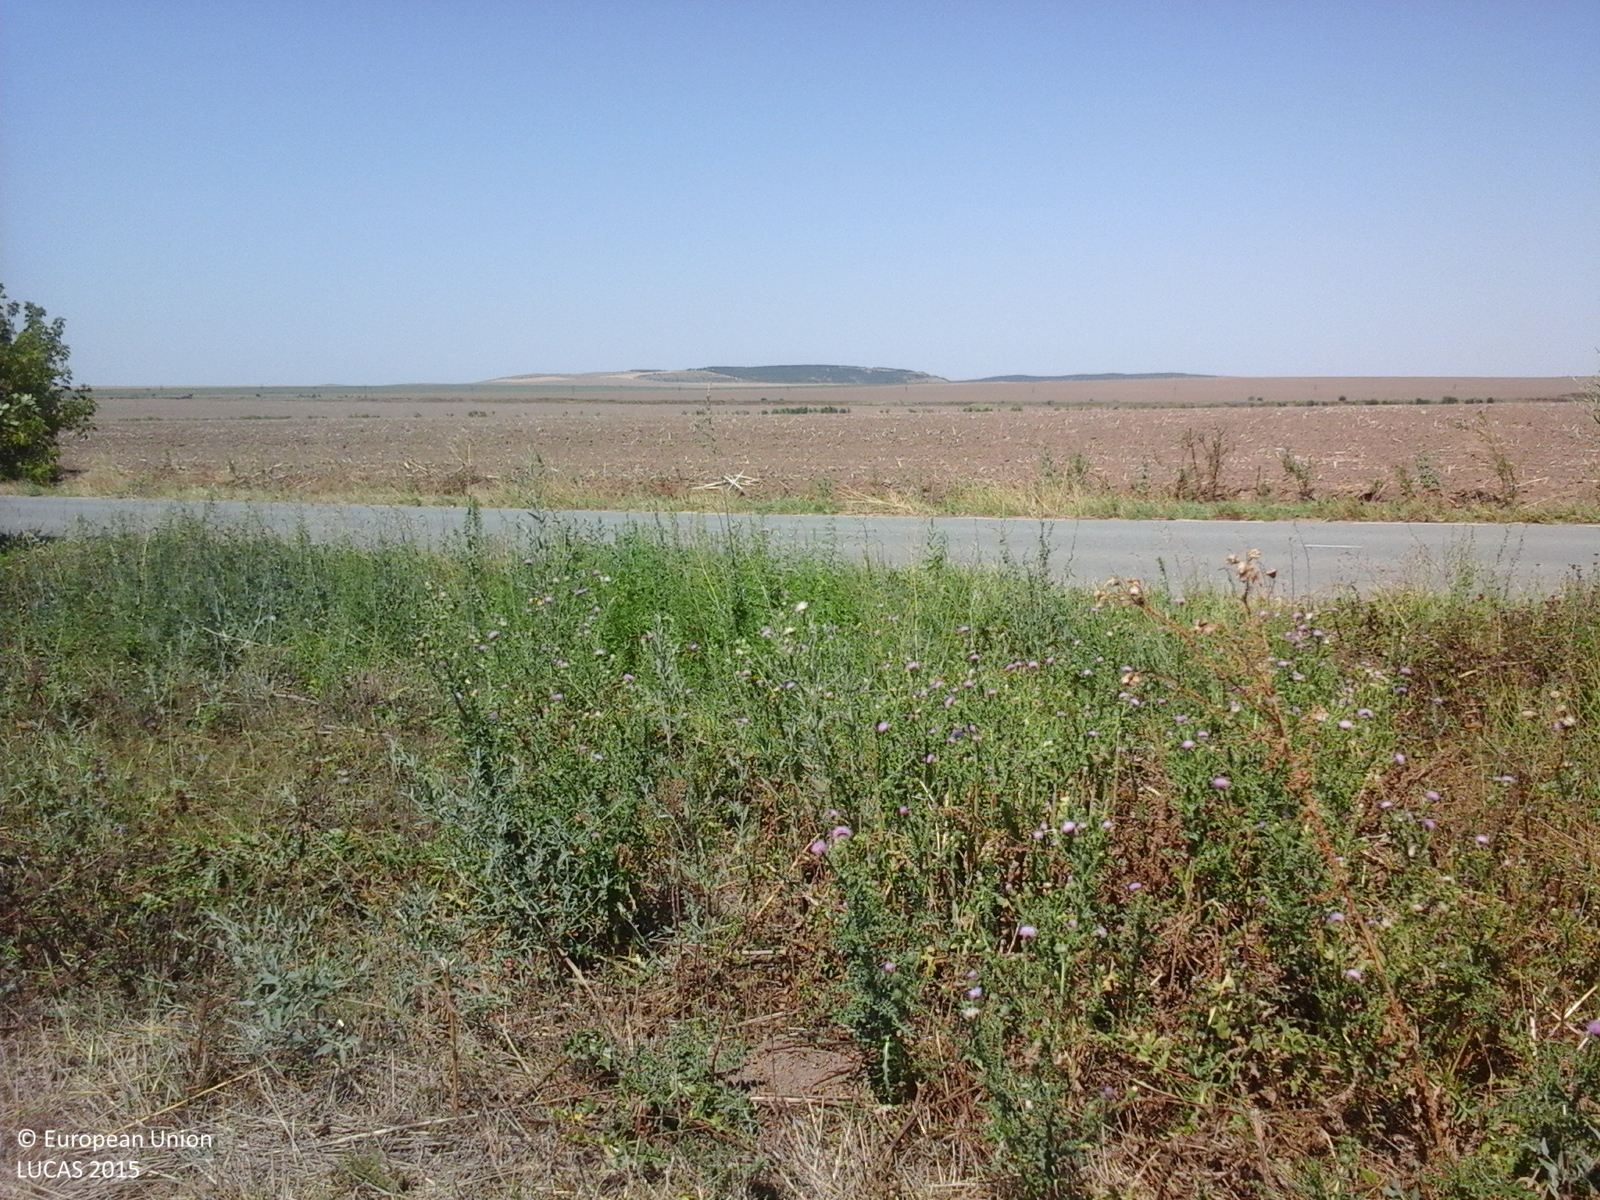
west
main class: Cropland
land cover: Rape and turnip rape
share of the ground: < 10 %
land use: Agriculture (excluding fallow land and kitchen gardens)
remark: Harvested field
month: August
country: RO
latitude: 44.4634
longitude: 28.2782
